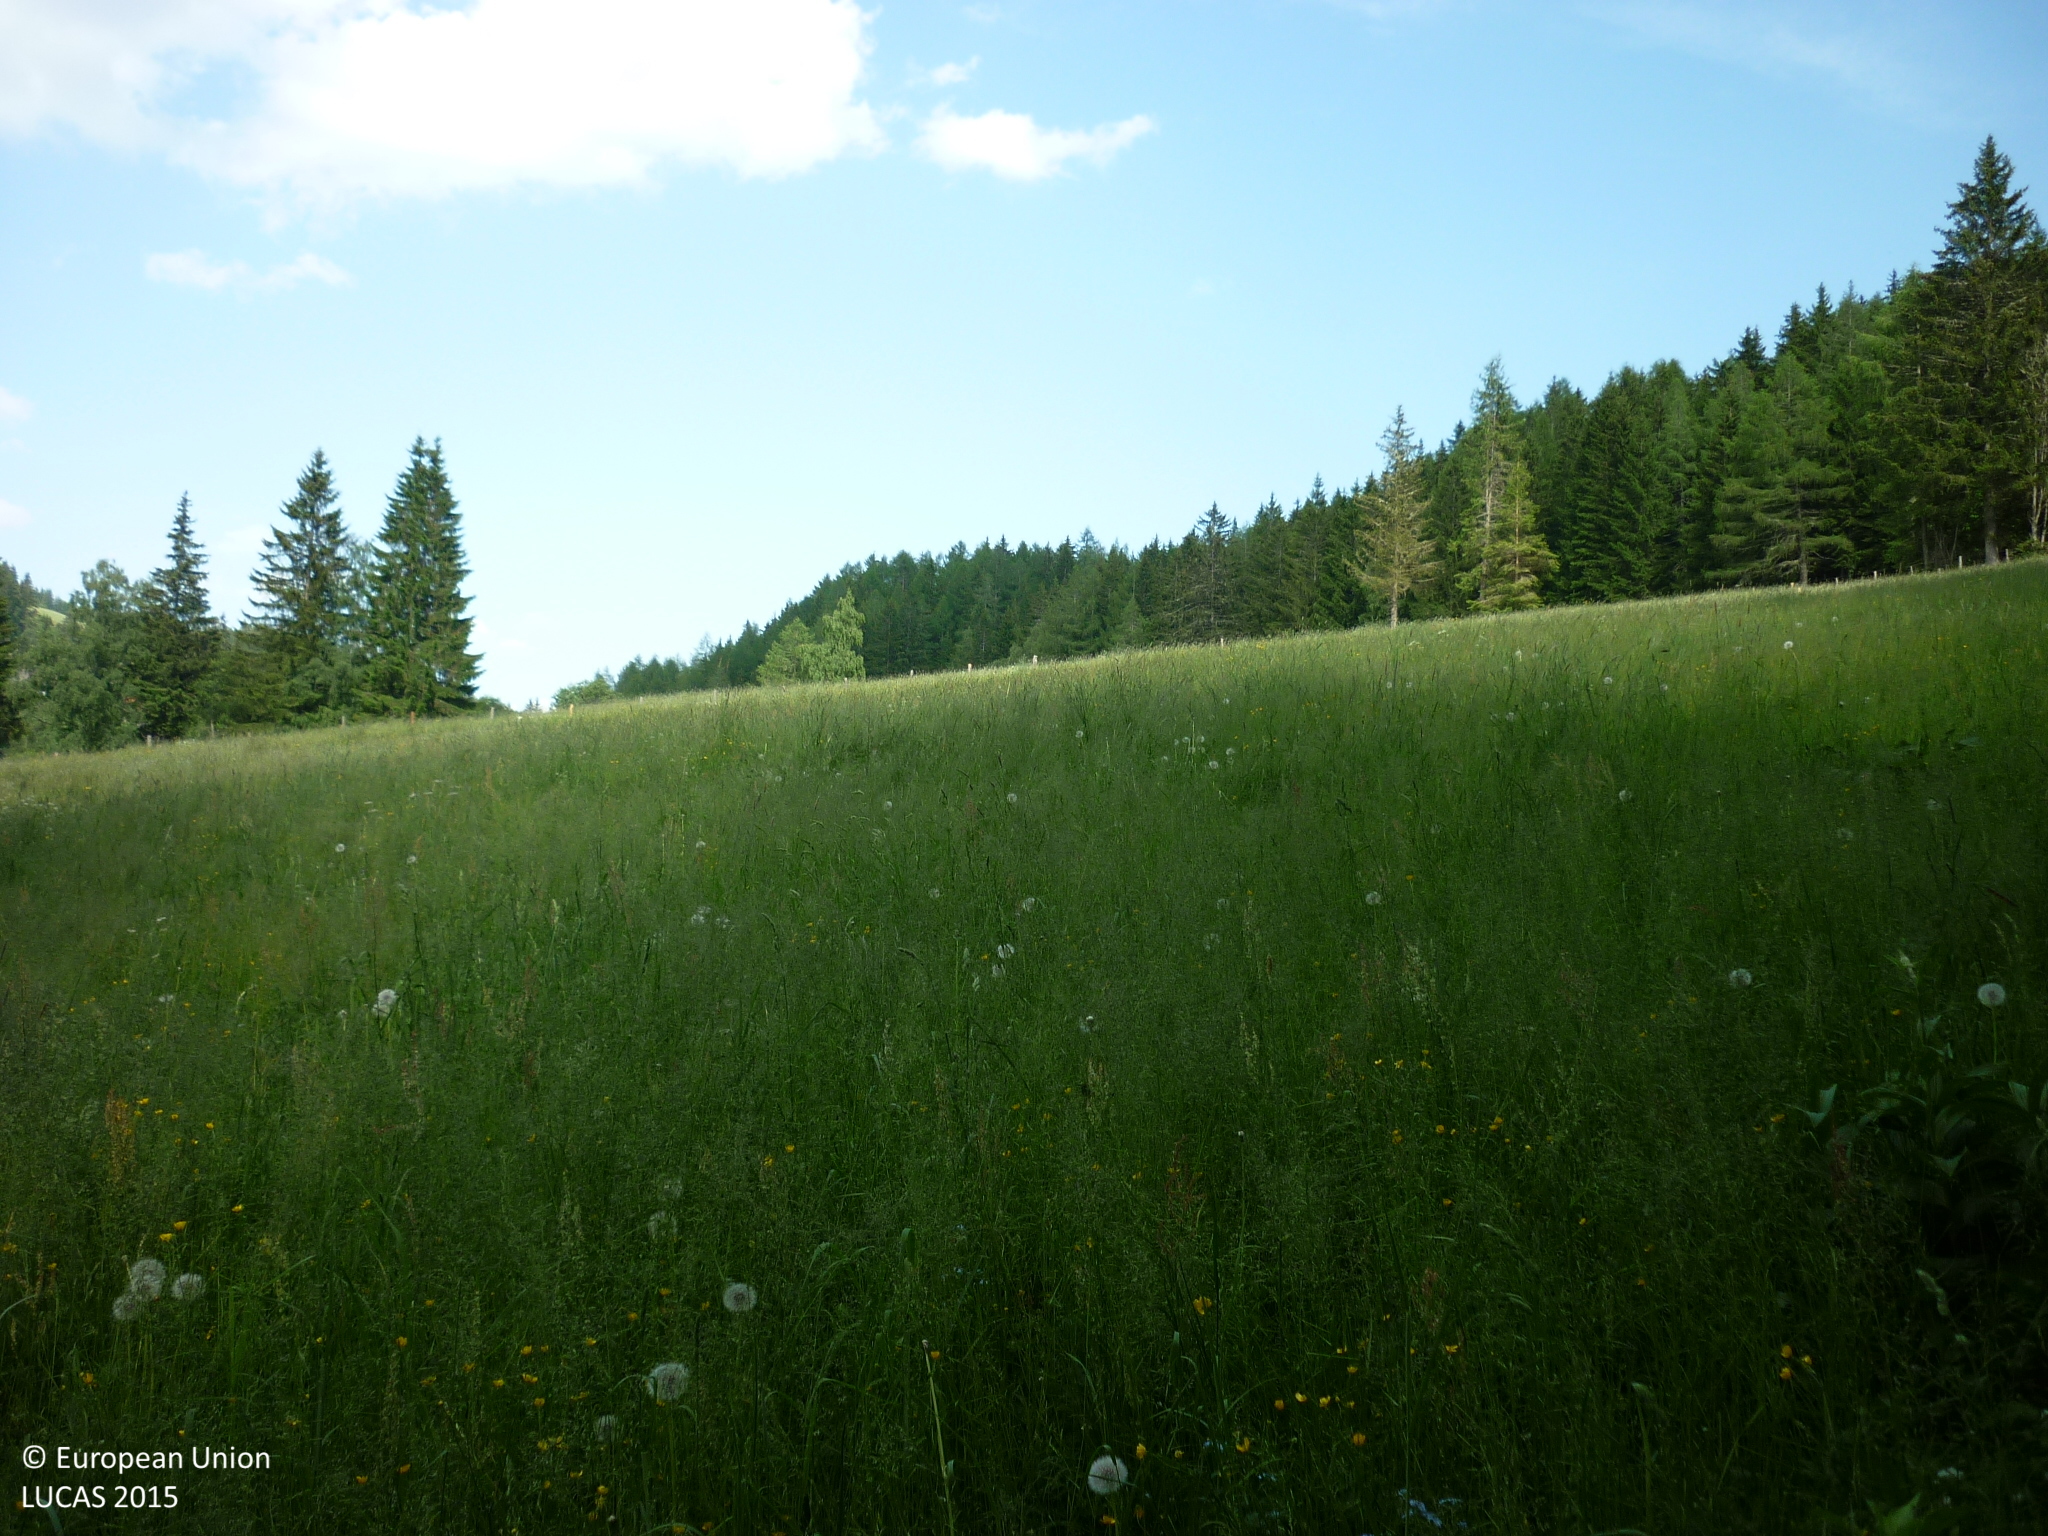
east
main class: Grassland
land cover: Grassland without tree/shrub cover
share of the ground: > 75 %
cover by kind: herbaceous plants 100 %
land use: Agriculture (excluding fallow land and kitchen gardens)
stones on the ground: < 10 %
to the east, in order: Grassland without tree/shrub cover; Fences; Grassland without tree/shrub cover; Fences; Grass margins; Tracks; Grass margins; Fences; Grassland without tree/shrub cover
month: June
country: AT
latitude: 47.2198
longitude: 14.3166
